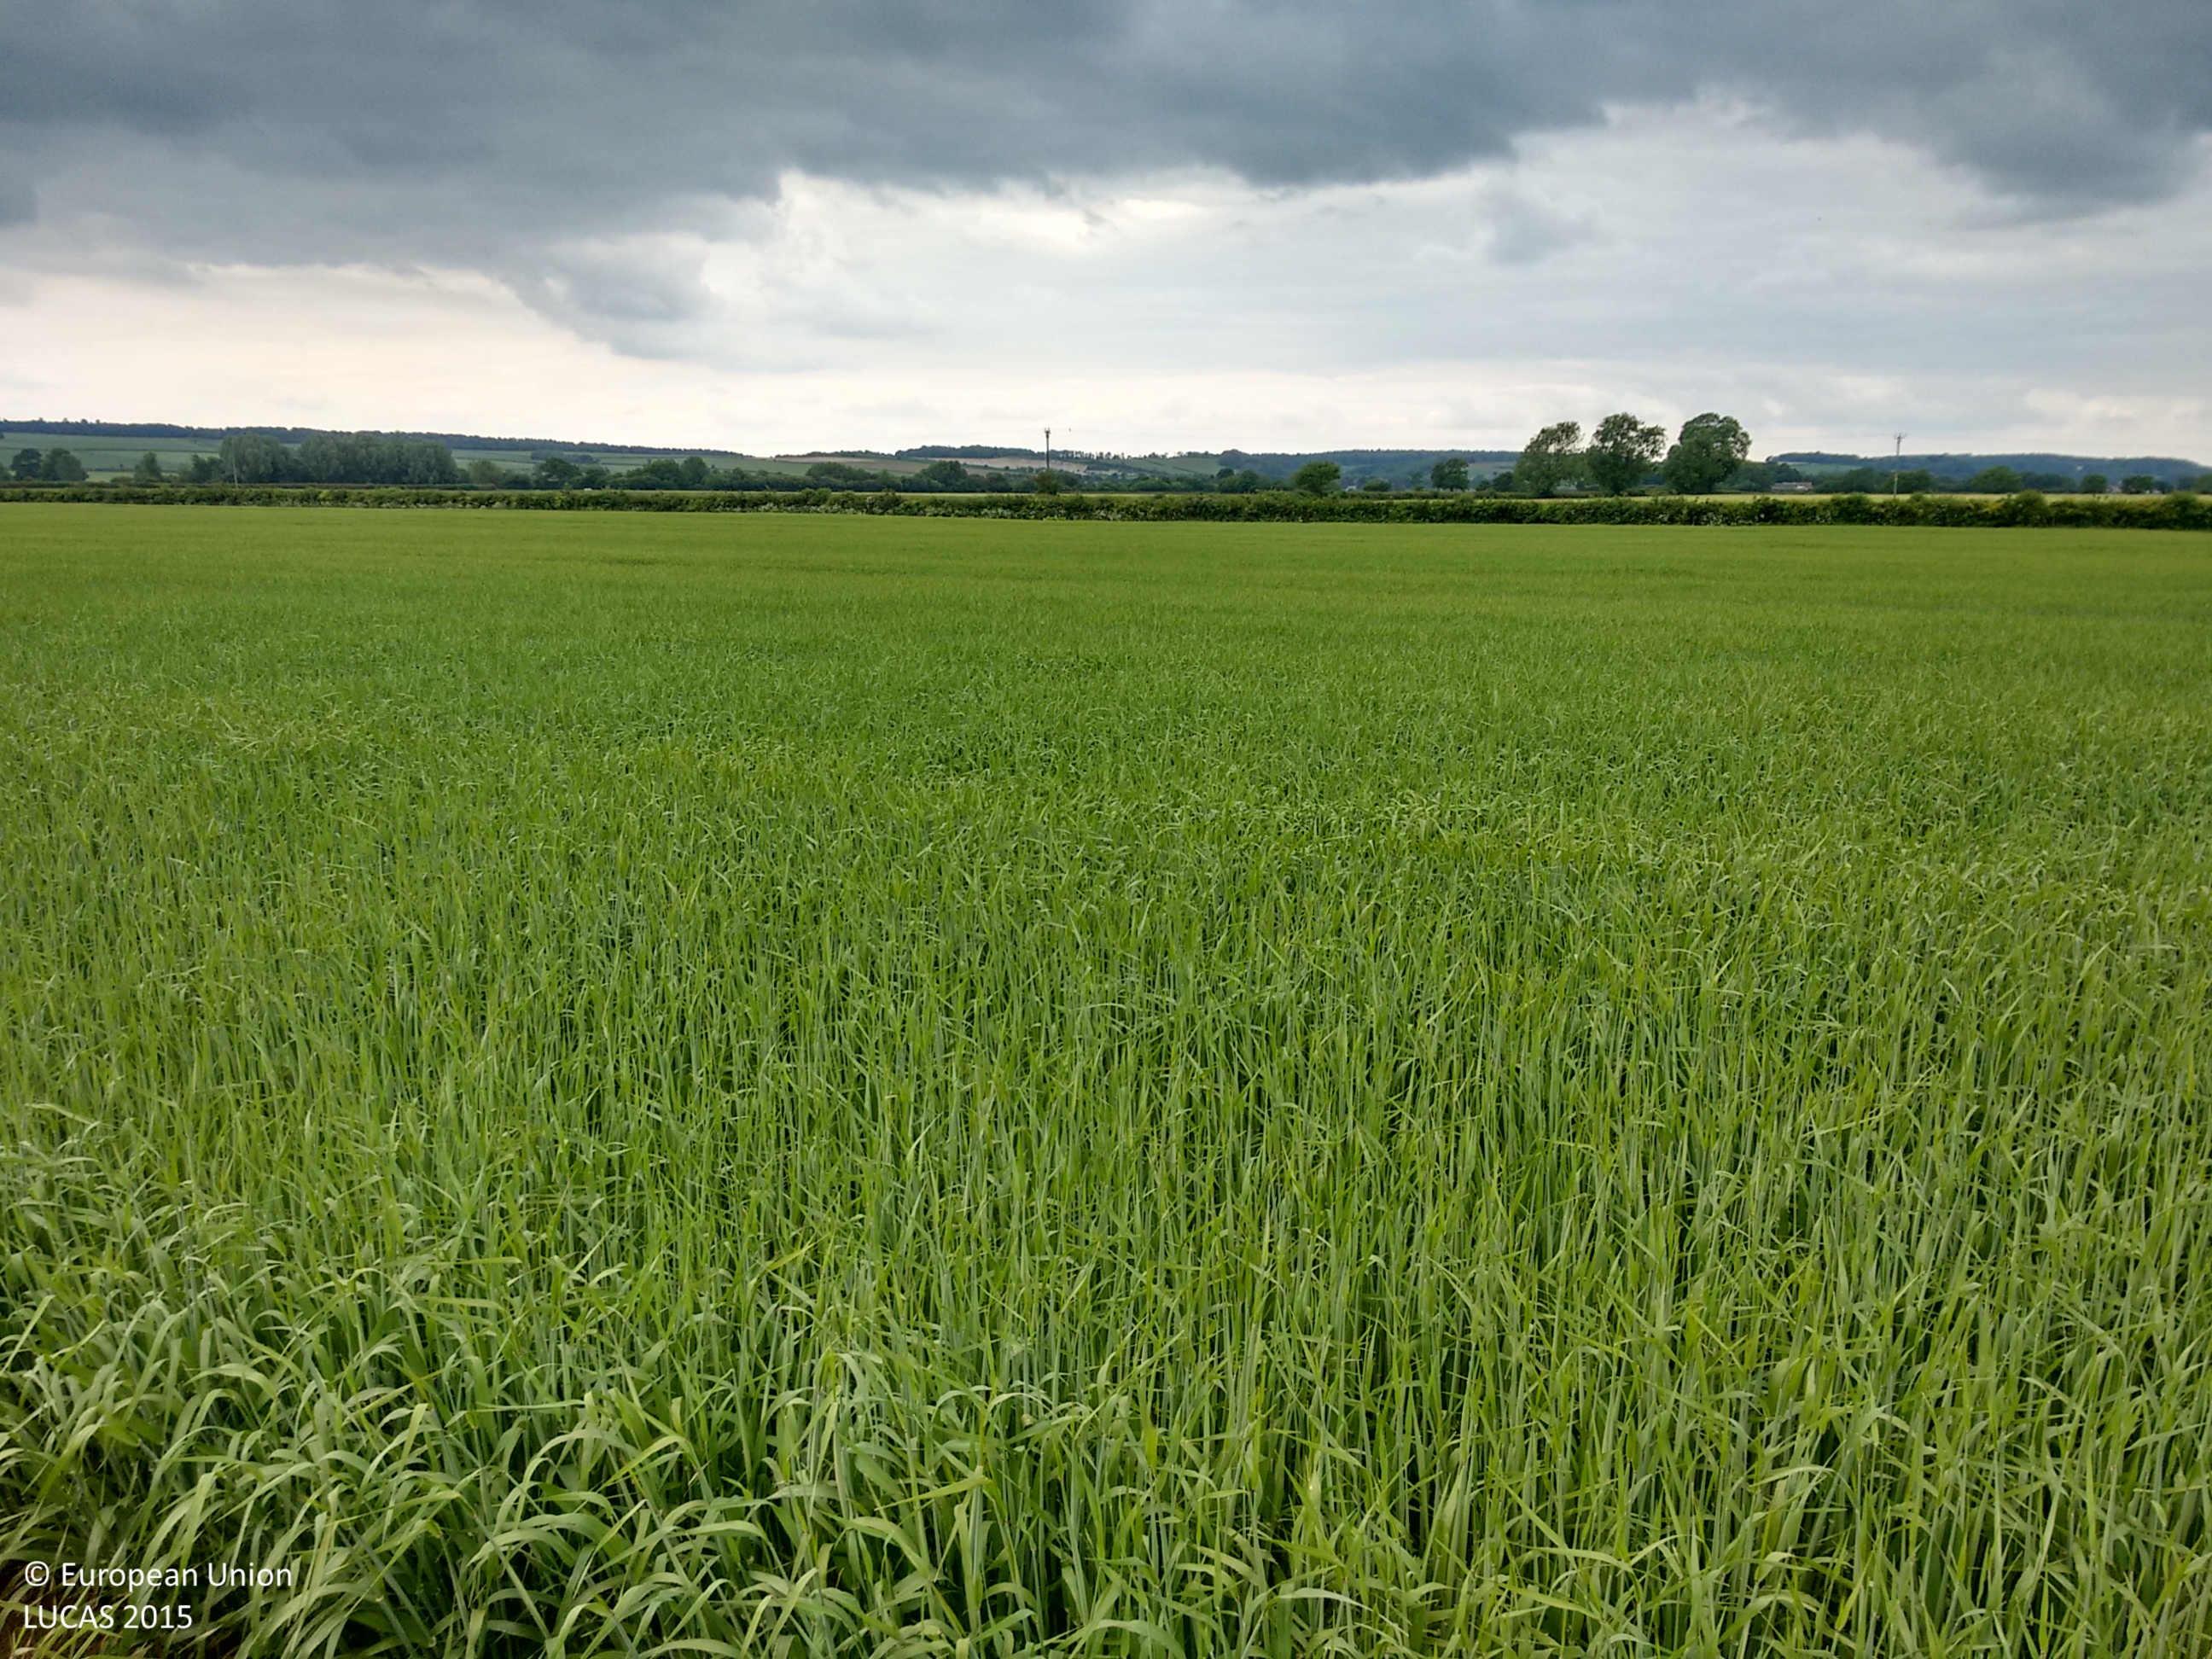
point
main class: Cropland
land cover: Barley
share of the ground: > 75 %
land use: Agriculture (excluding fallow land and kitchen gardens)
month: June
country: GB
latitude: 54.1757
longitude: -0.9342
